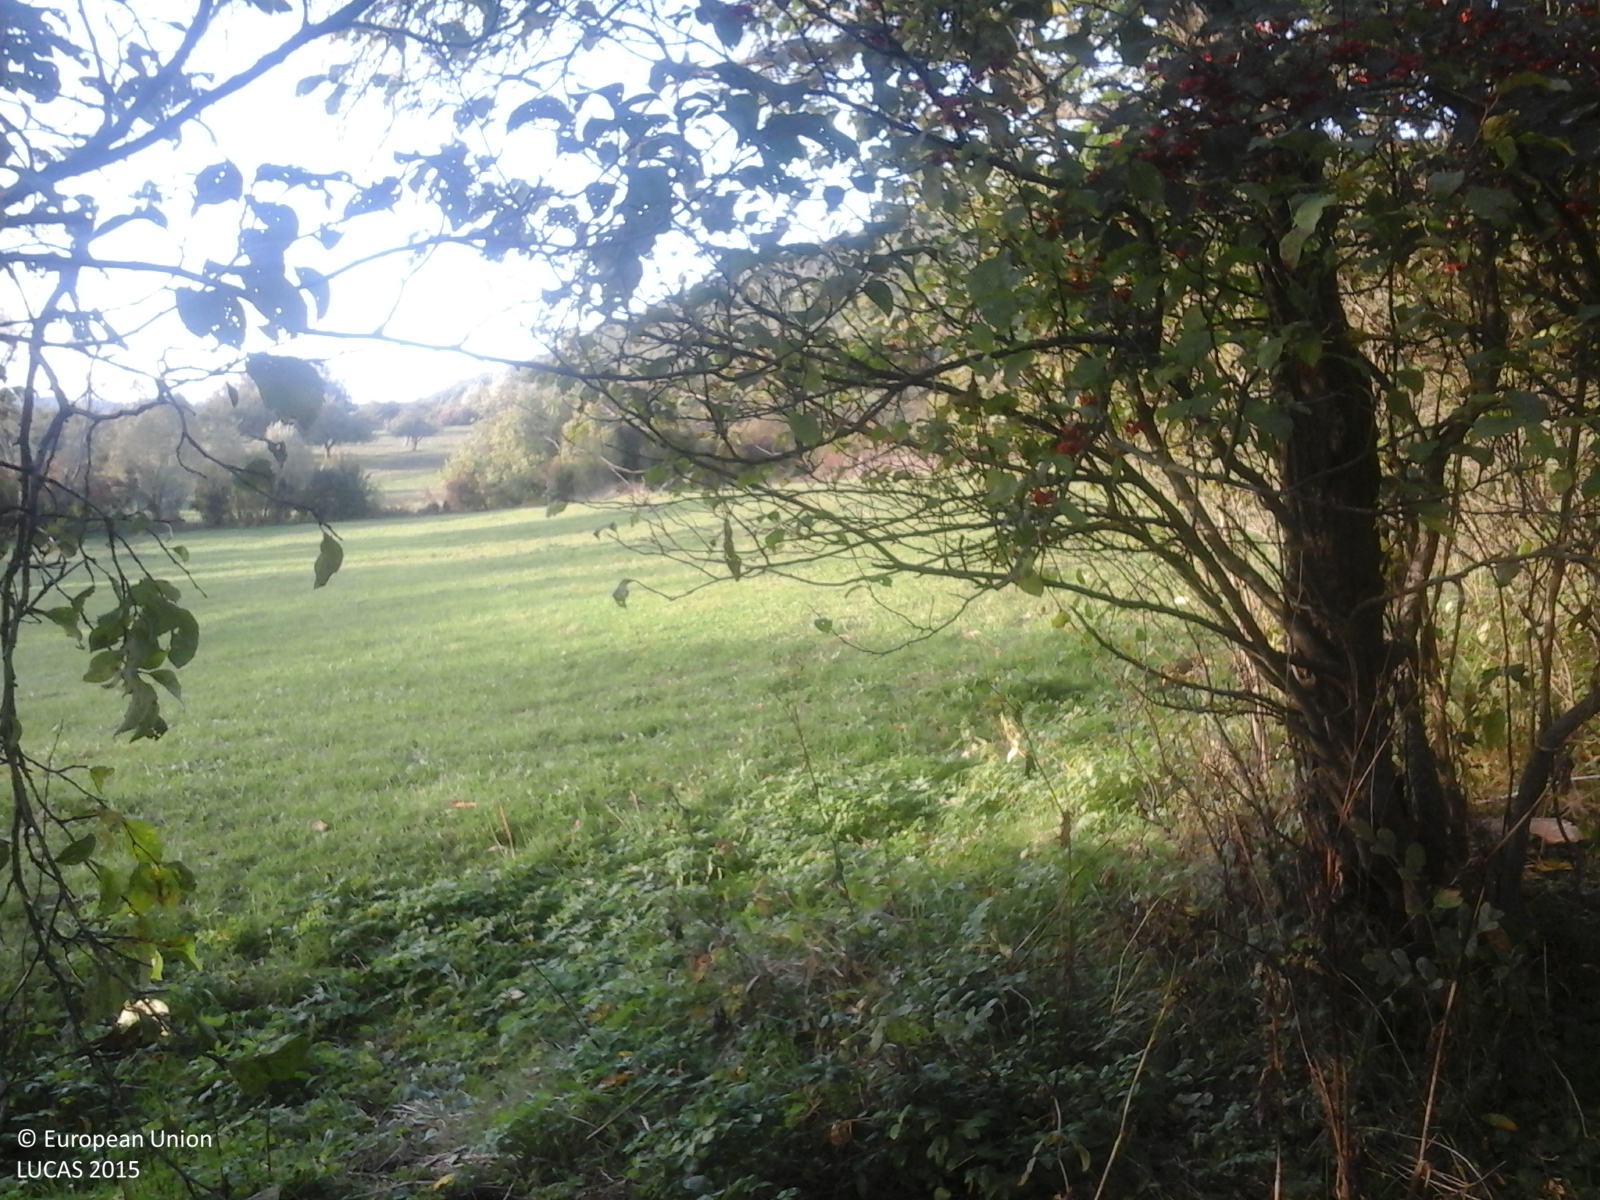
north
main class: Woodland
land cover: Broadleaved woodland
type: acidophilous oak and oak-birch forest
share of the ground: > 75 %
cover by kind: broadleaved forest trees 100 %
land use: Forestry
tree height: > 5 m
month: October
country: RO
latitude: 46.2714
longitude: 25.4036
